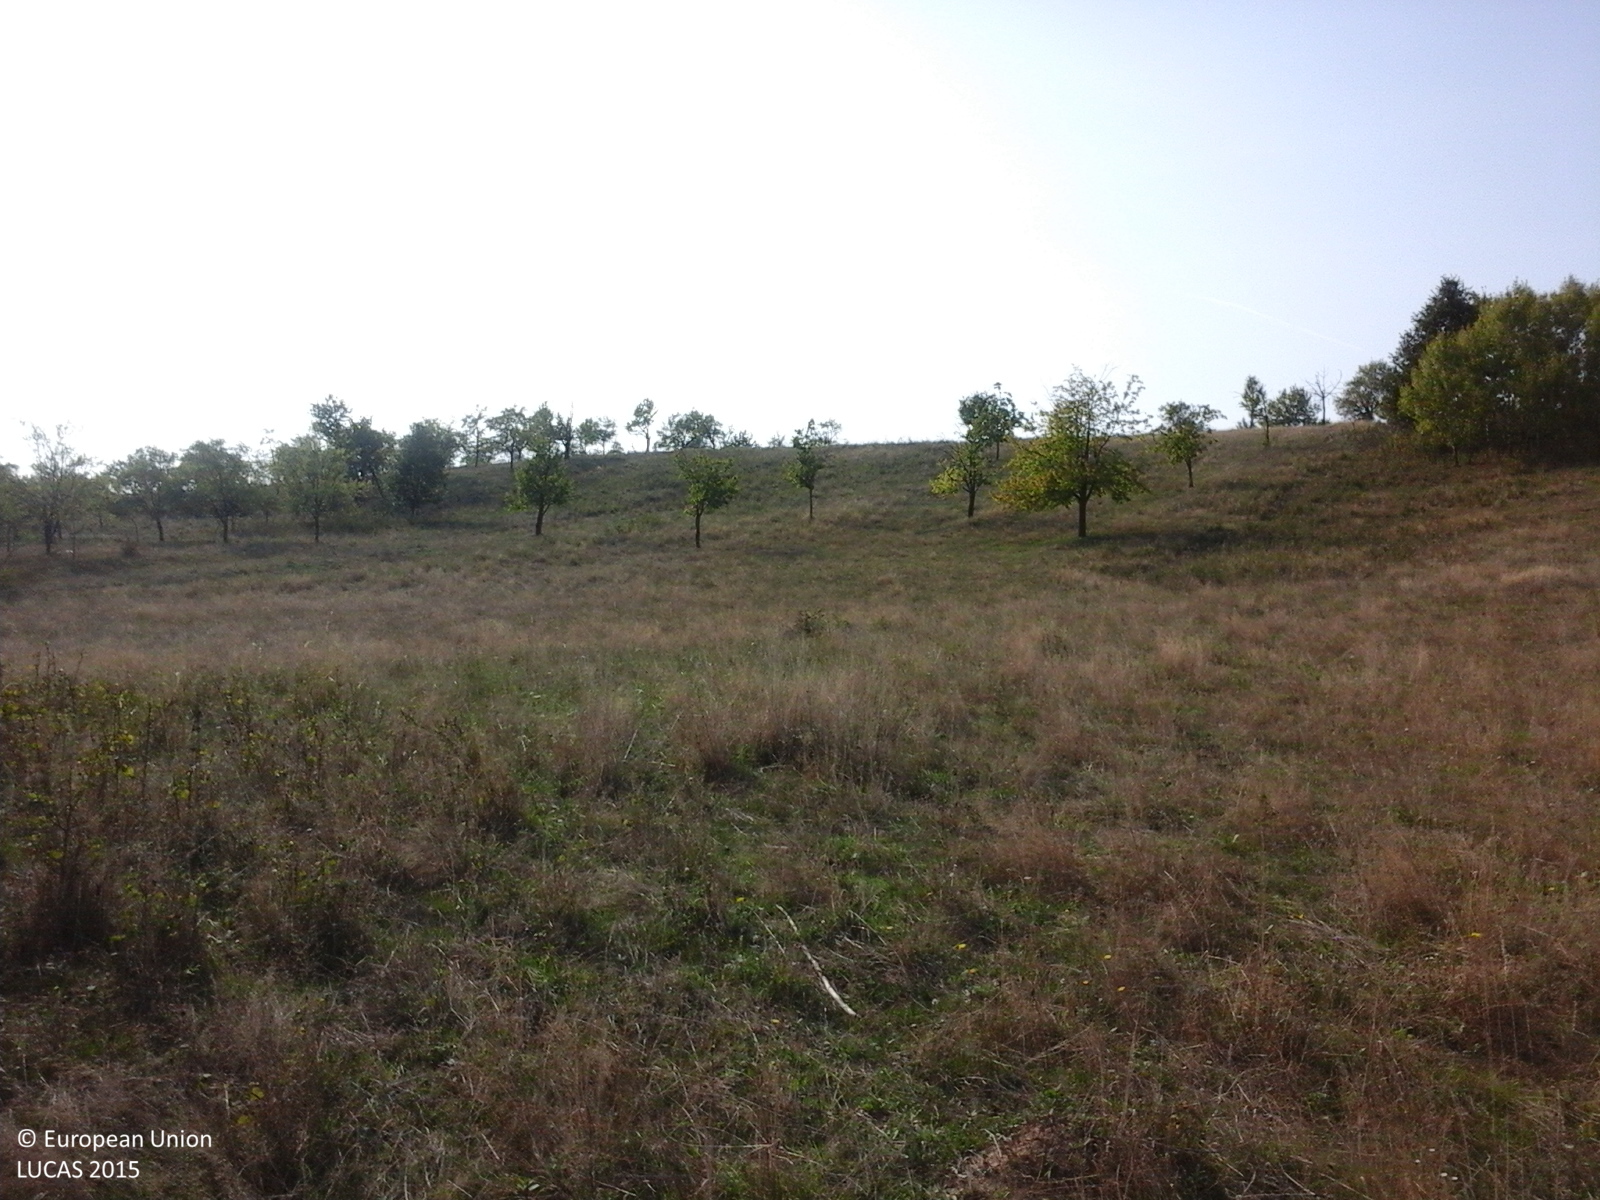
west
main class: Grassland
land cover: Grassland with sparse tree/shrub cover
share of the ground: > 75 %
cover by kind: herbaceous plants 95 %, broadleaved forest trees 5 %
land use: Agriculture (excluding fallow land and kitchen gardens)
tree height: < 5 m
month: September
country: RO
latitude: 45.7865
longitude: 22.1203
